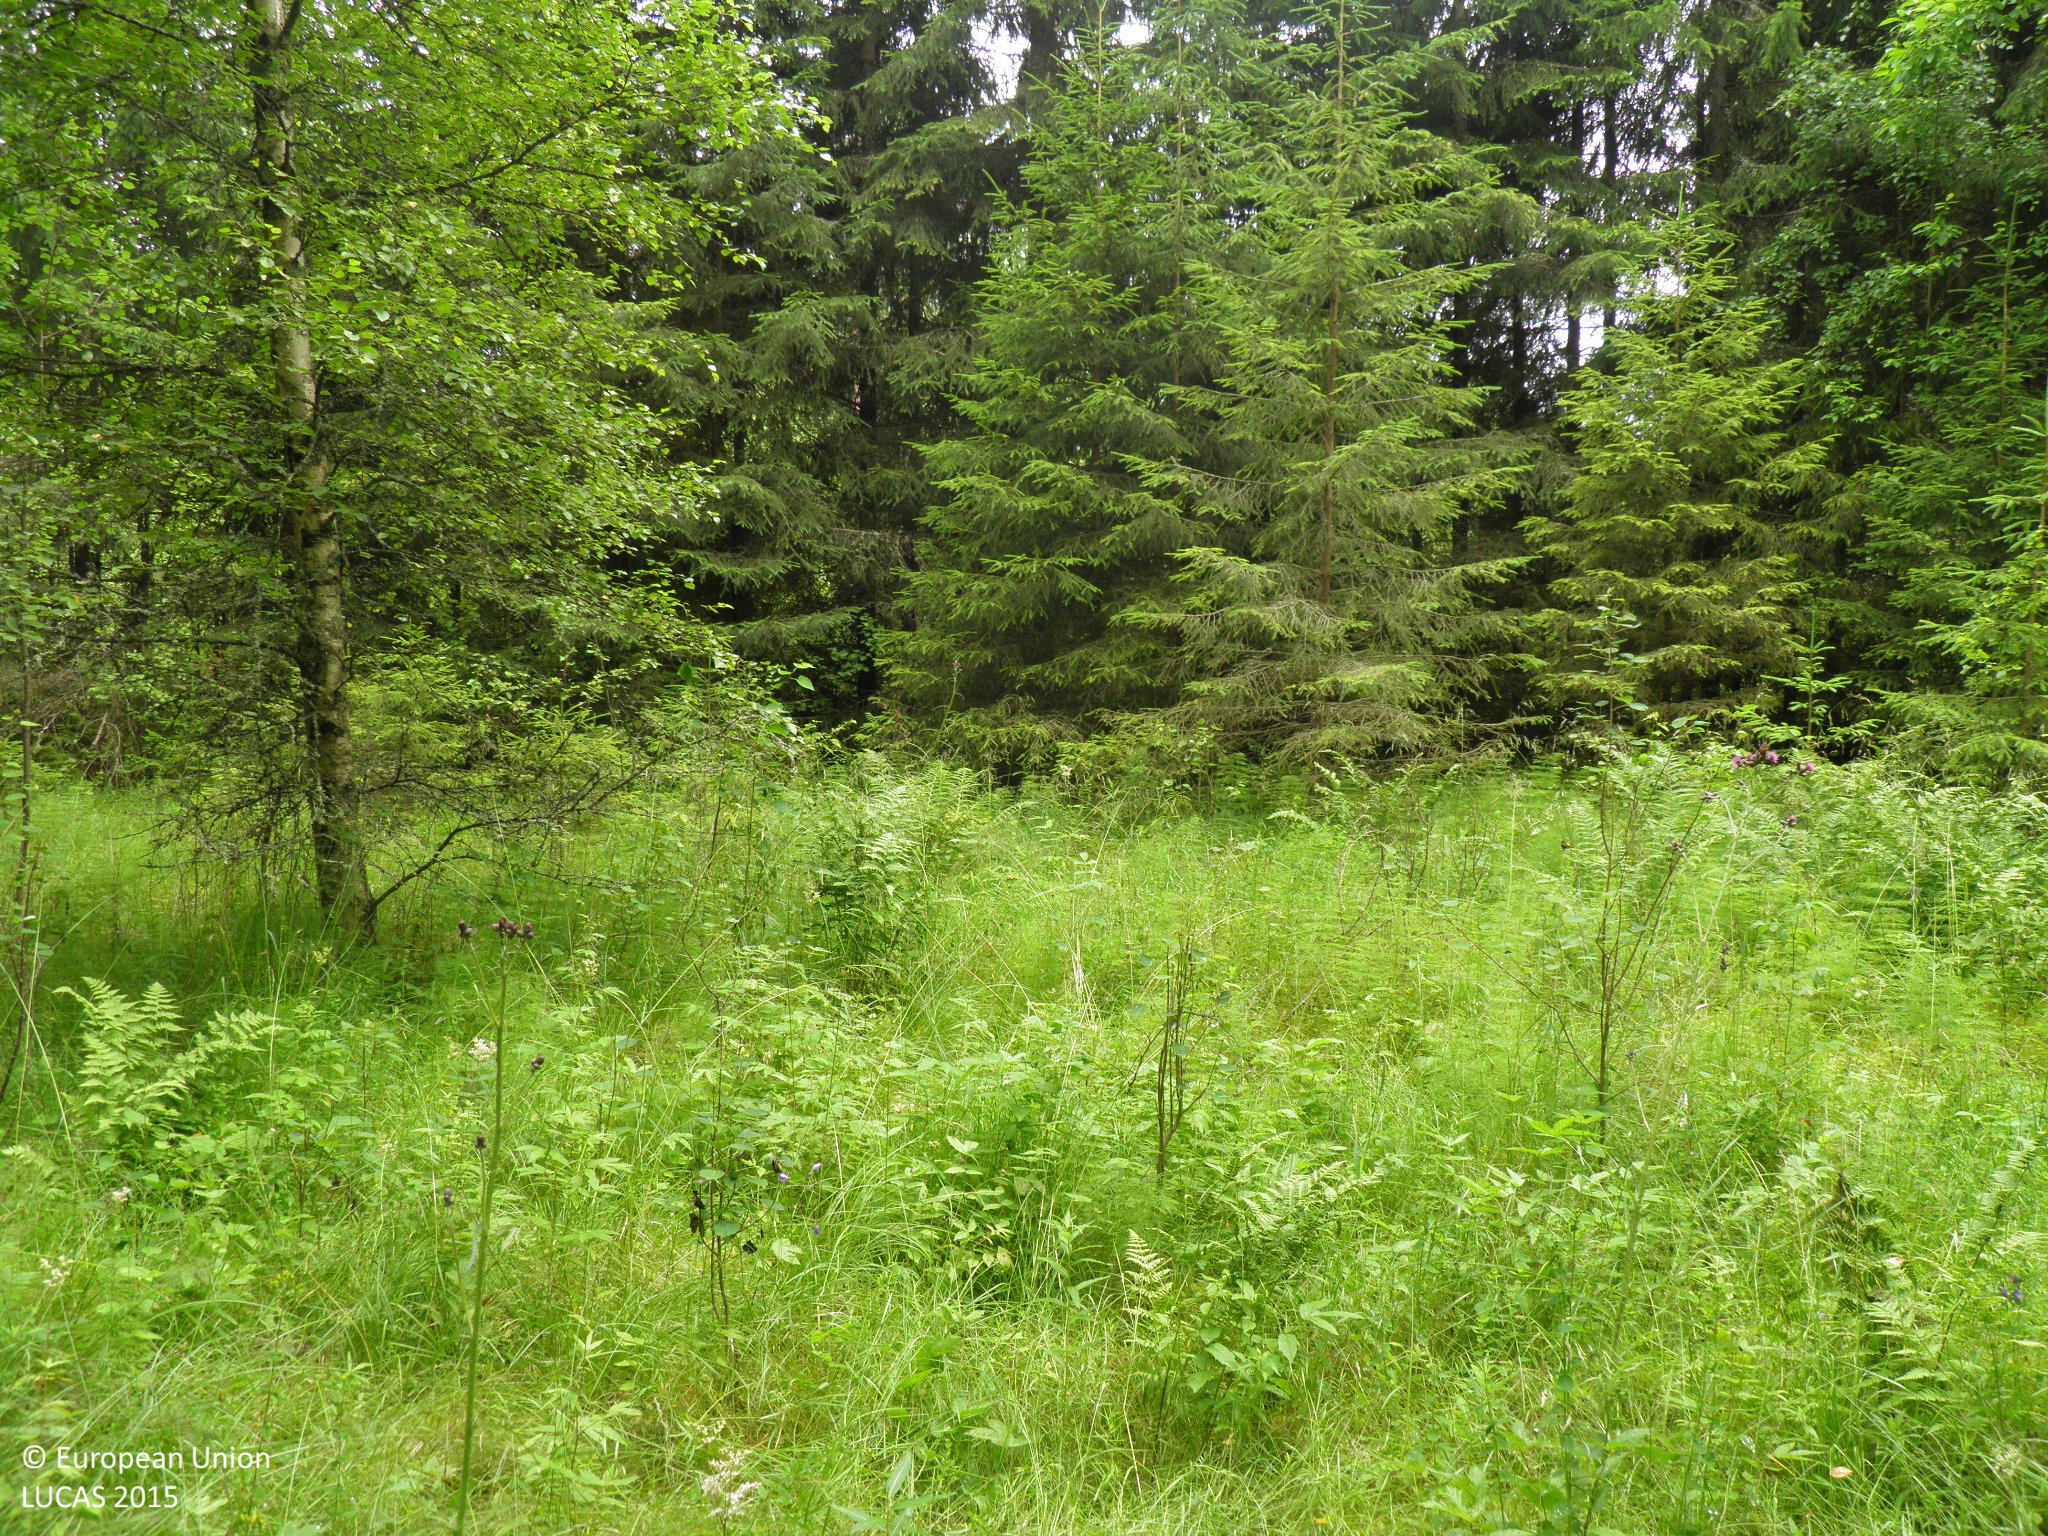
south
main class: Woodland
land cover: Spruce dominated coniferous woodland
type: boreal forest
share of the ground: > 75 %
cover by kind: coniferous forest trees 90 %, unconsolidated bare surface 10 %
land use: Forestry
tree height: > 5 m
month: July
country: FI
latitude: 60.0696
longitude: 22.5981
